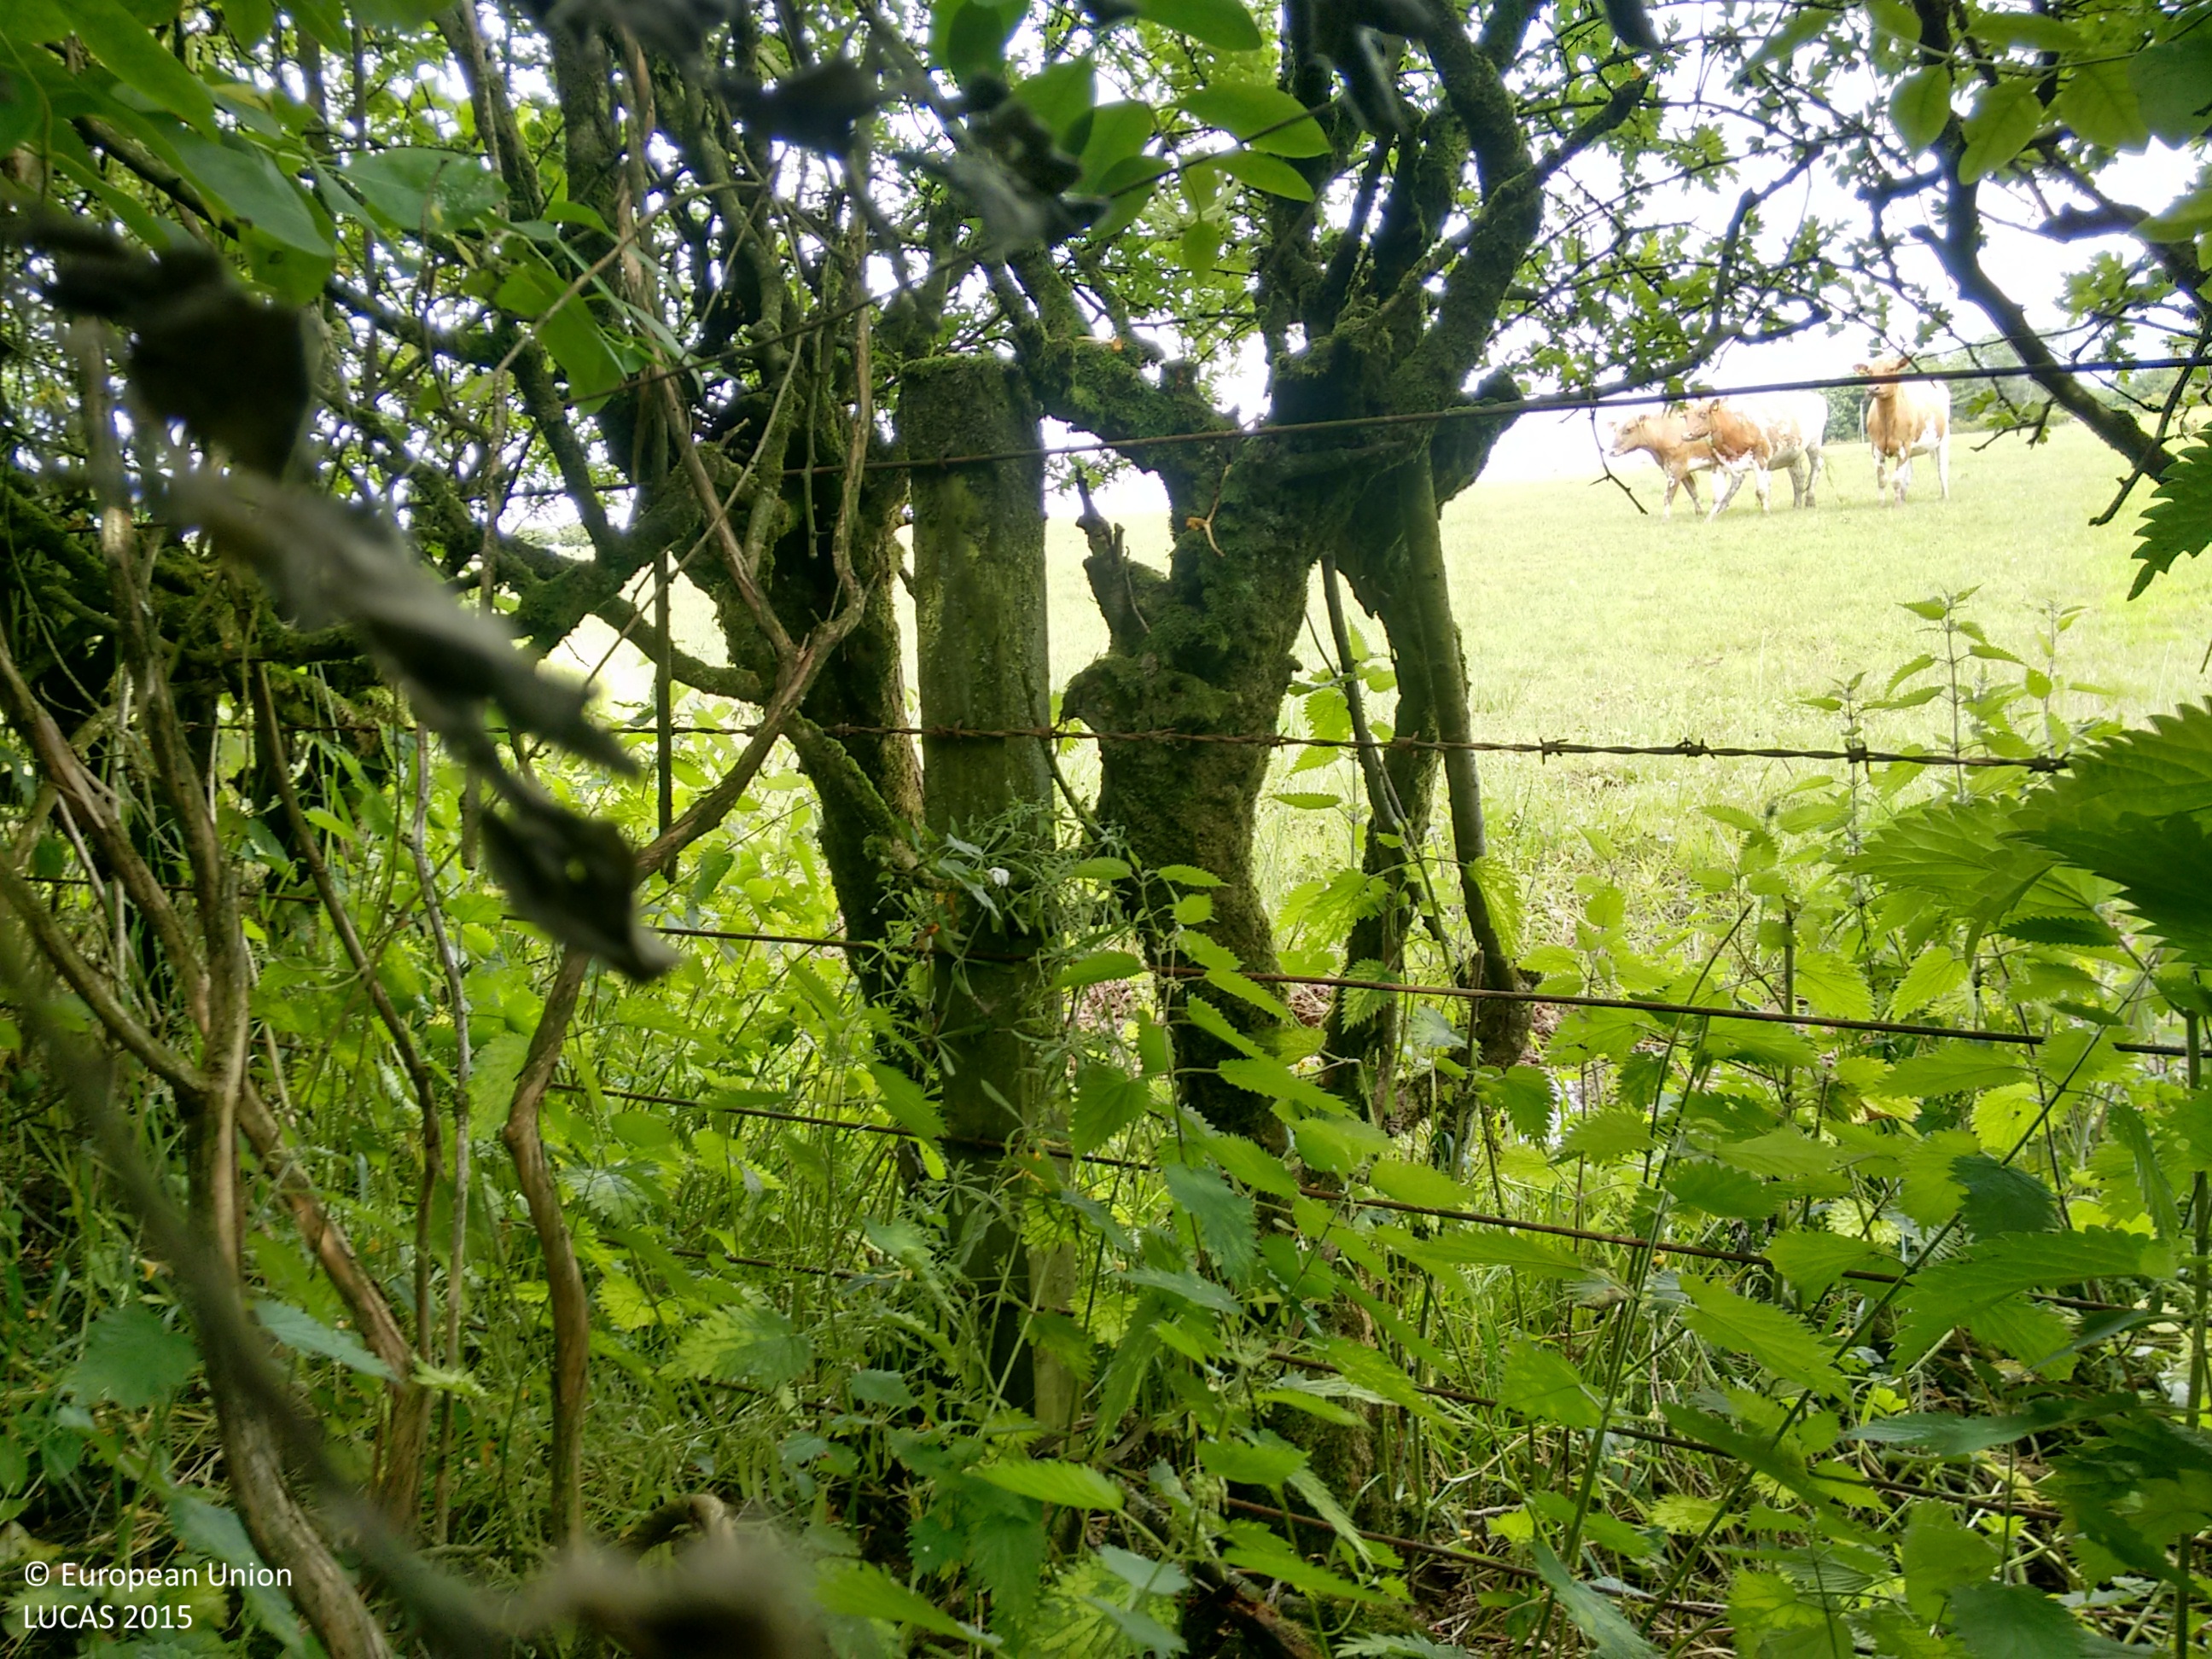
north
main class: Grassland
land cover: Grassland without tree/shrub cover
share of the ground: < 10 %
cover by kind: herbaceous plants 100 %
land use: Agriculture (excluding fallow land and kitchen gardens)
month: July
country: GB
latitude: 55.5372
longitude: -4.3740
